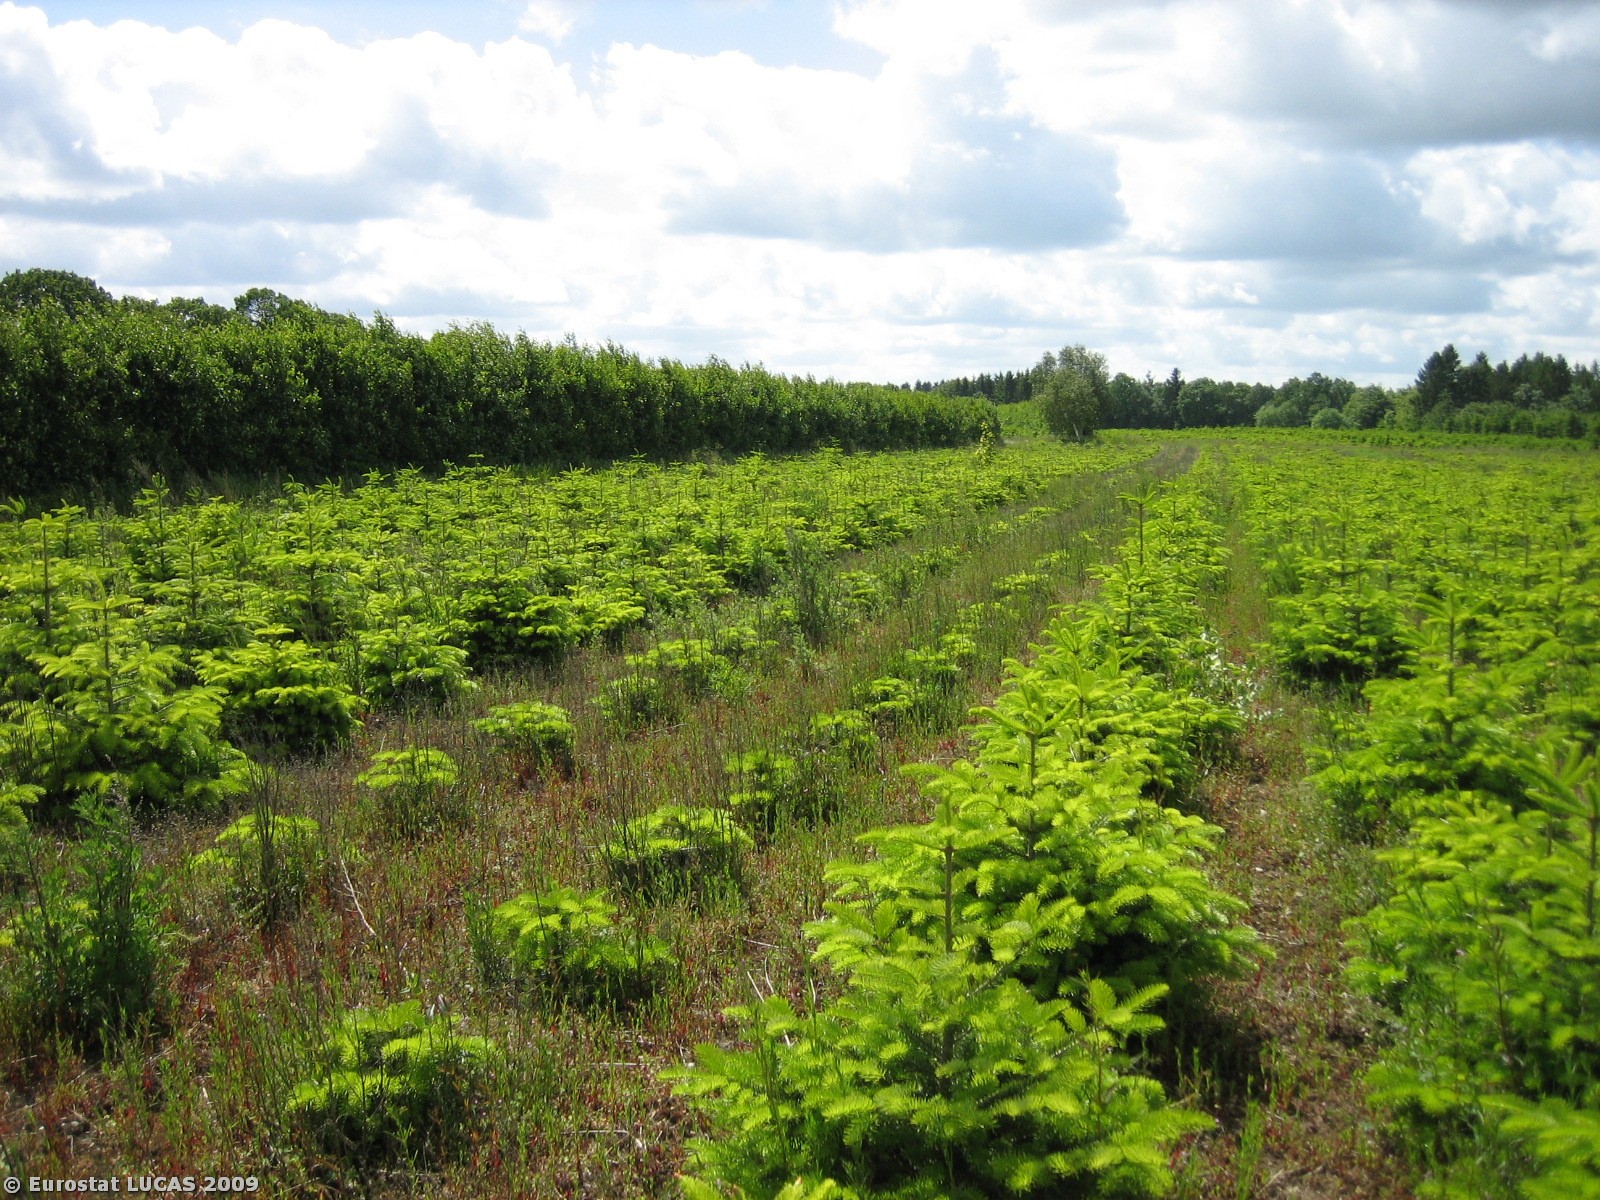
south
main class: Woodland
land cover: Coniferous woodland
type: hemiboreal forest and nemoral coniferous forest and mixed broadleaved-coniferous forest
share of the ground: 50 - 75 %
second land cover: Spontaneously vegetated surfaces
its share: 25 - 50 %
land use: Agriculture (excluding fallow land and kitchen gardens)
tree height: > 5 m
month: June
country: DK
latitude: 55.7184
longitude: 9.2844
